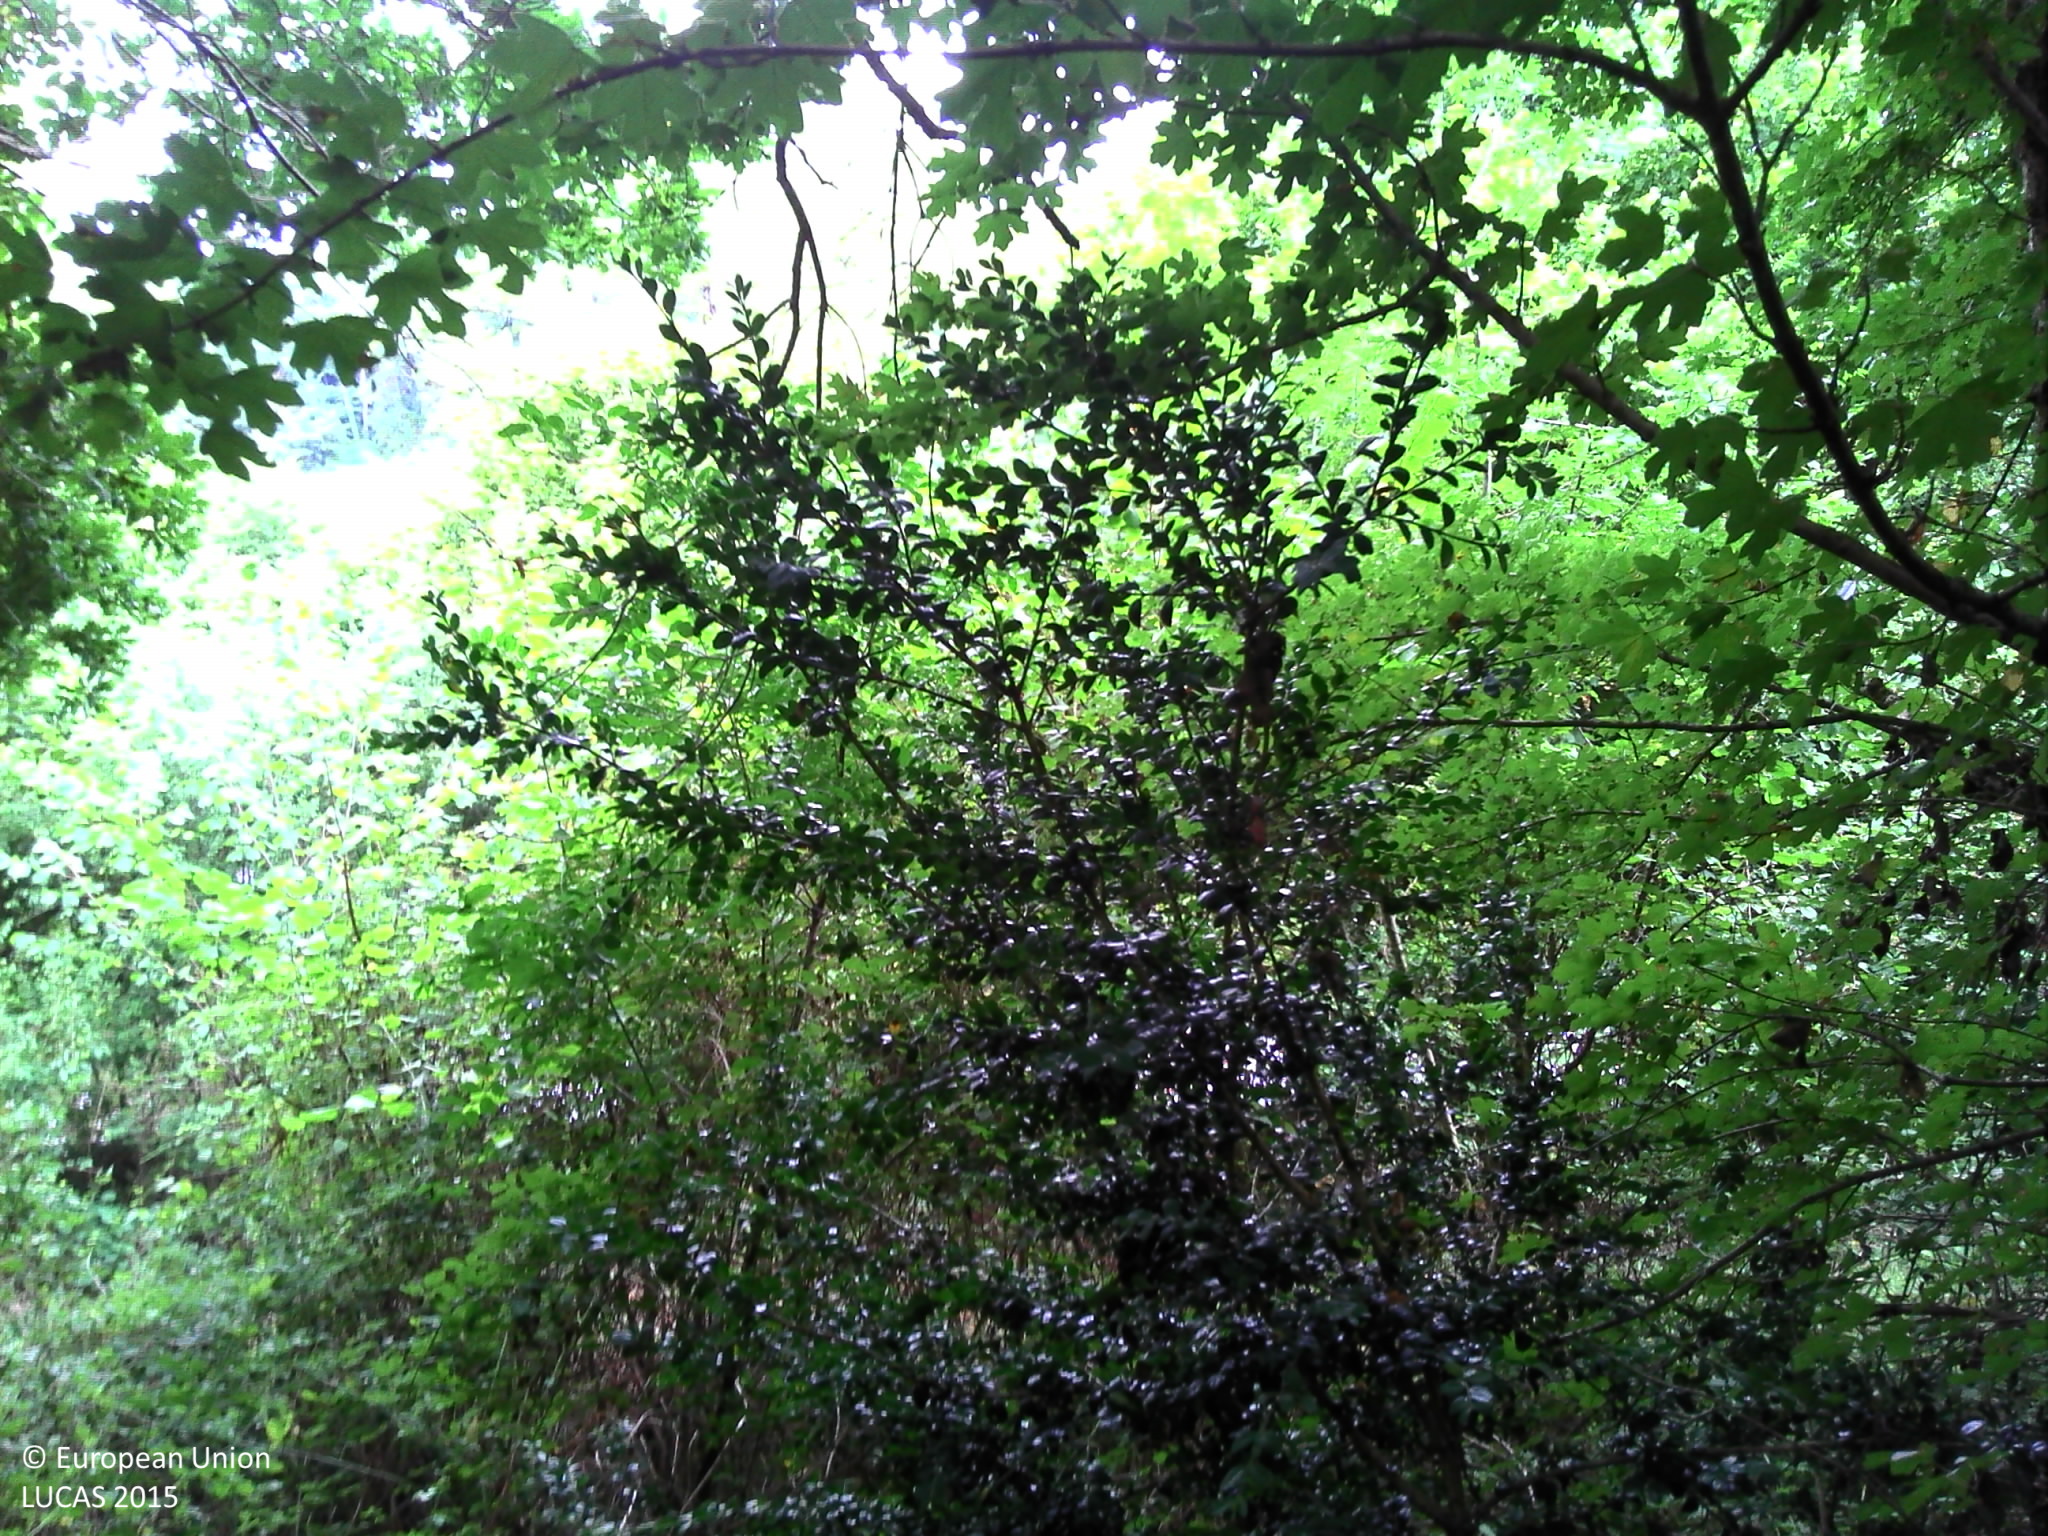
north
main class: Woodland
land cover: Broadleaved woodland
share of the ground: > 75 %
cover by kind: shrubs 60 %, broadleaved forest trees 20 %, herbaceous plants 20 %
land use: Semi-natural and natural areas not in use
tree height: < 5 m
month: August
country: FR
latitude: 46.1509
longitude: 0.3628
